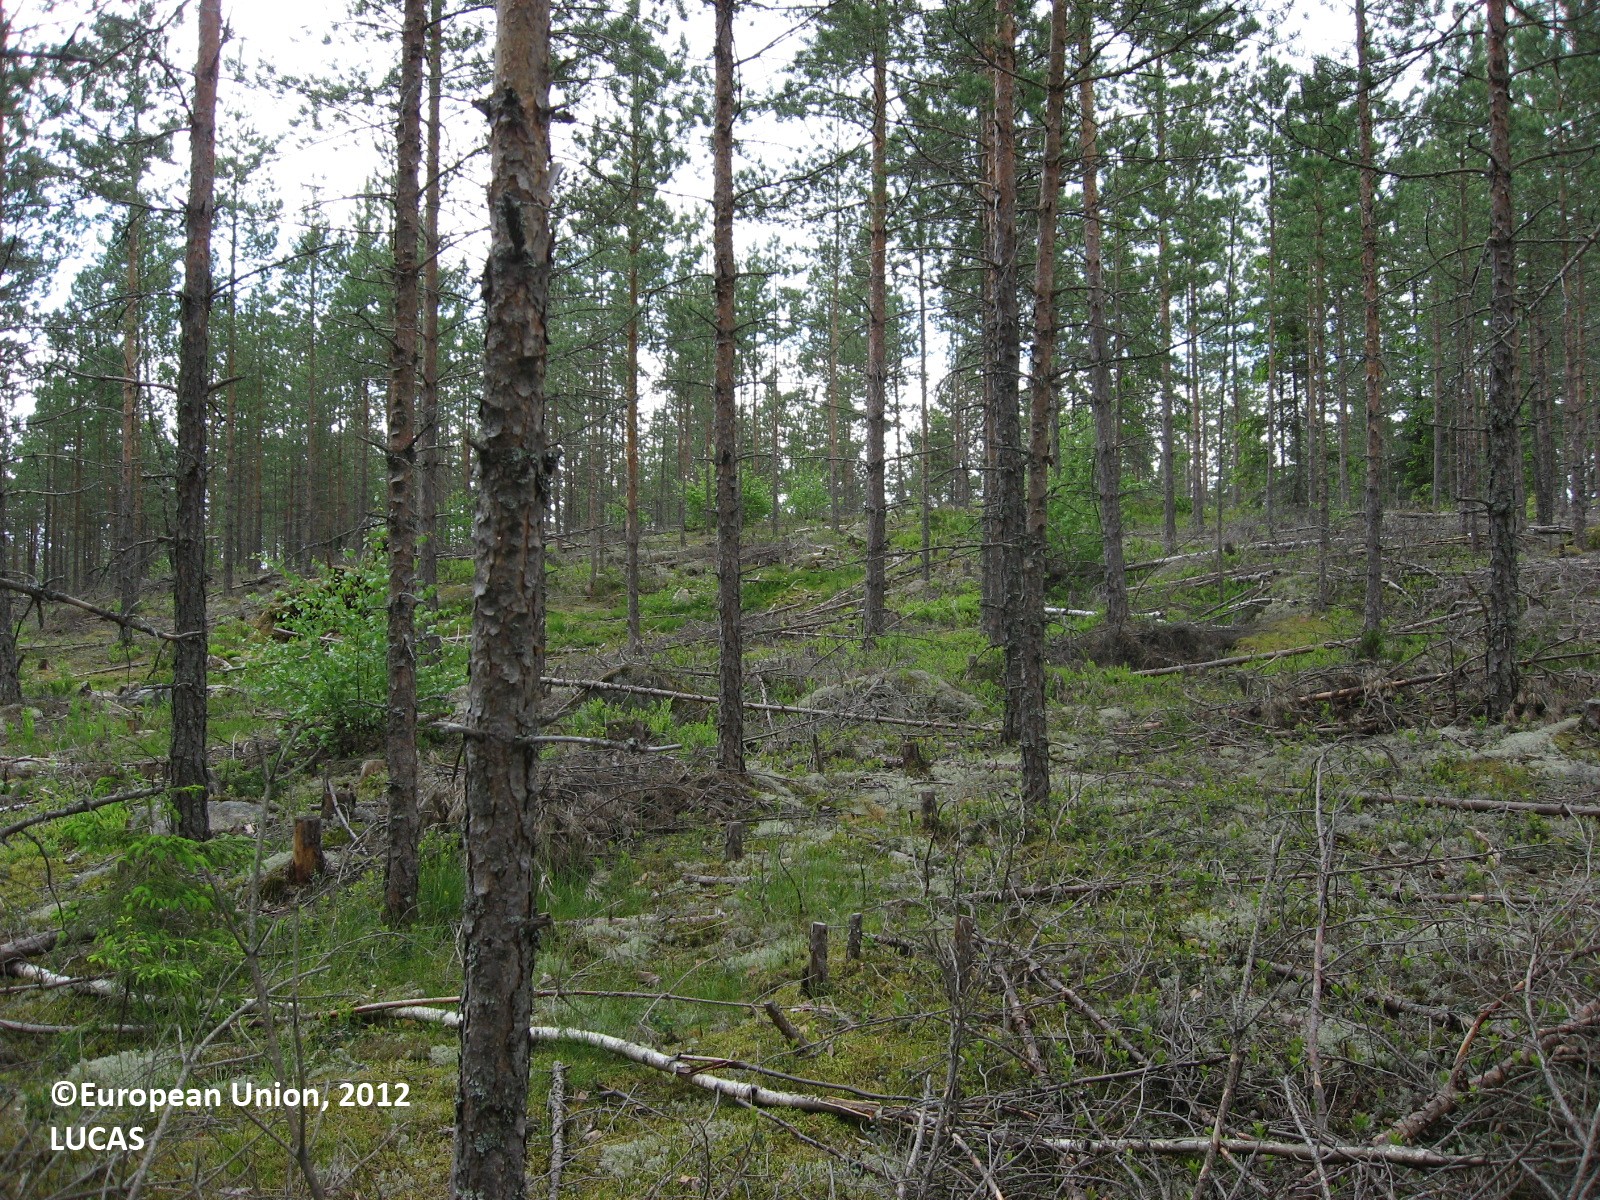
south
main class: Woodland
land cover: Pine dominated mixed woodland
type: boreal forest
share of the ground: > 75 %
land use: Forestry
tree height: > 5 m
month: June
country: FI
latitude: 60.4383
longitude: 25.3349
